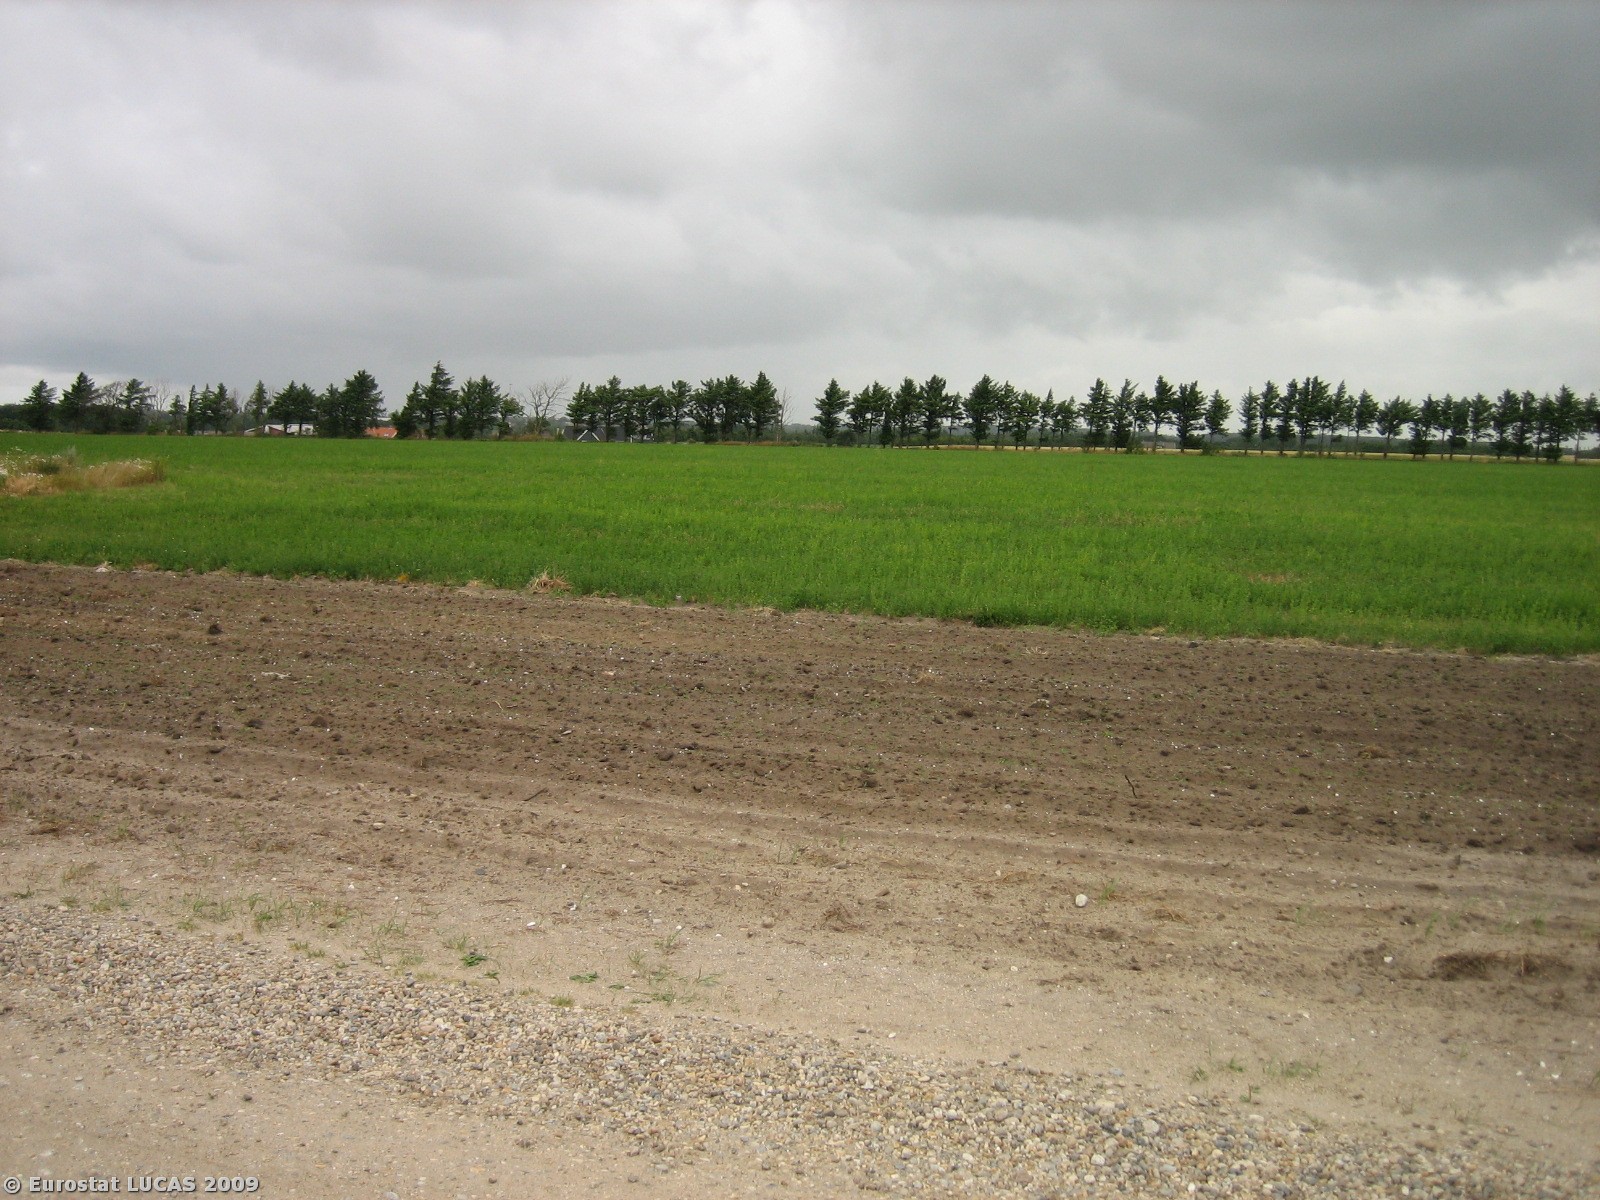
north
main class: Cropland
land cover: Barley
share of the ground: > 75 %
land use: Agriculture (excluding fallow land and kitchen gardens)
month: July
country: DK
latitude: 55.6012
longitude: 8.3033
